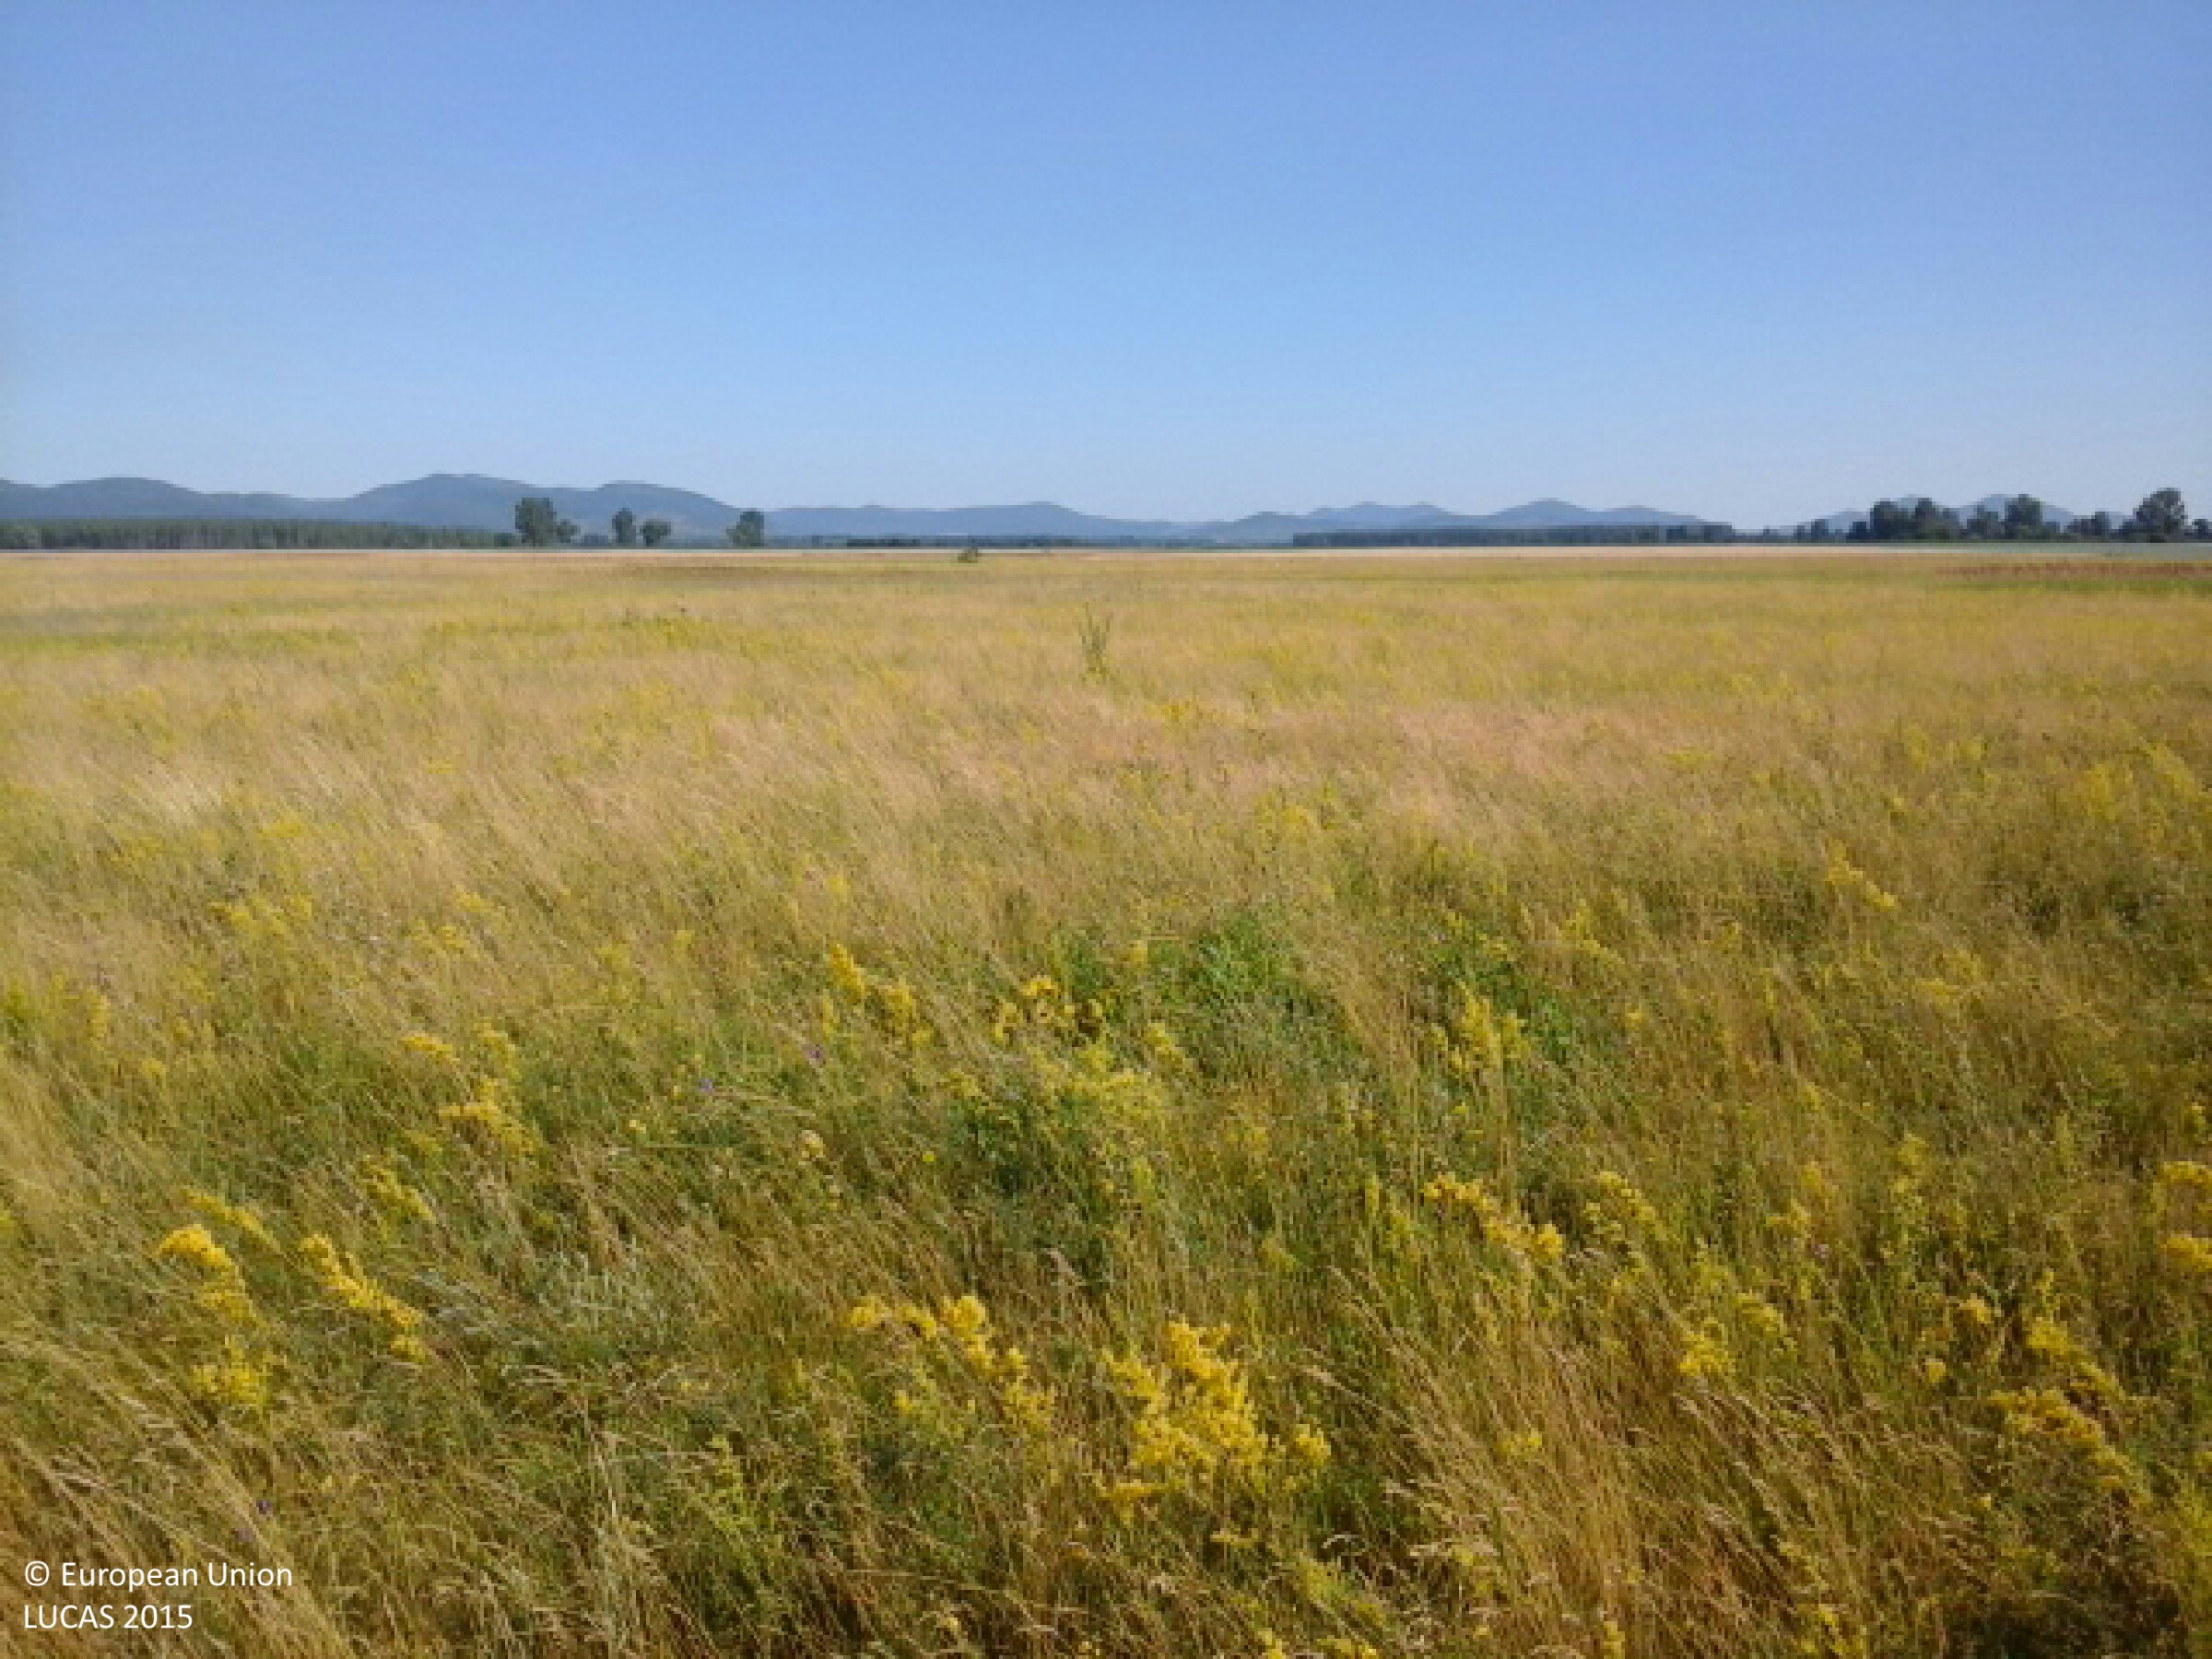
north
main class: Grassland
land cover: Grassland without tree/shrub cover
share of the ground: > 75 %
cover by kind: herbaceous plants 100 %
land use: Semi-natural and natural areas not in use
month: July
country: HU
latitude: 48.2313
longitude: 21.5575
